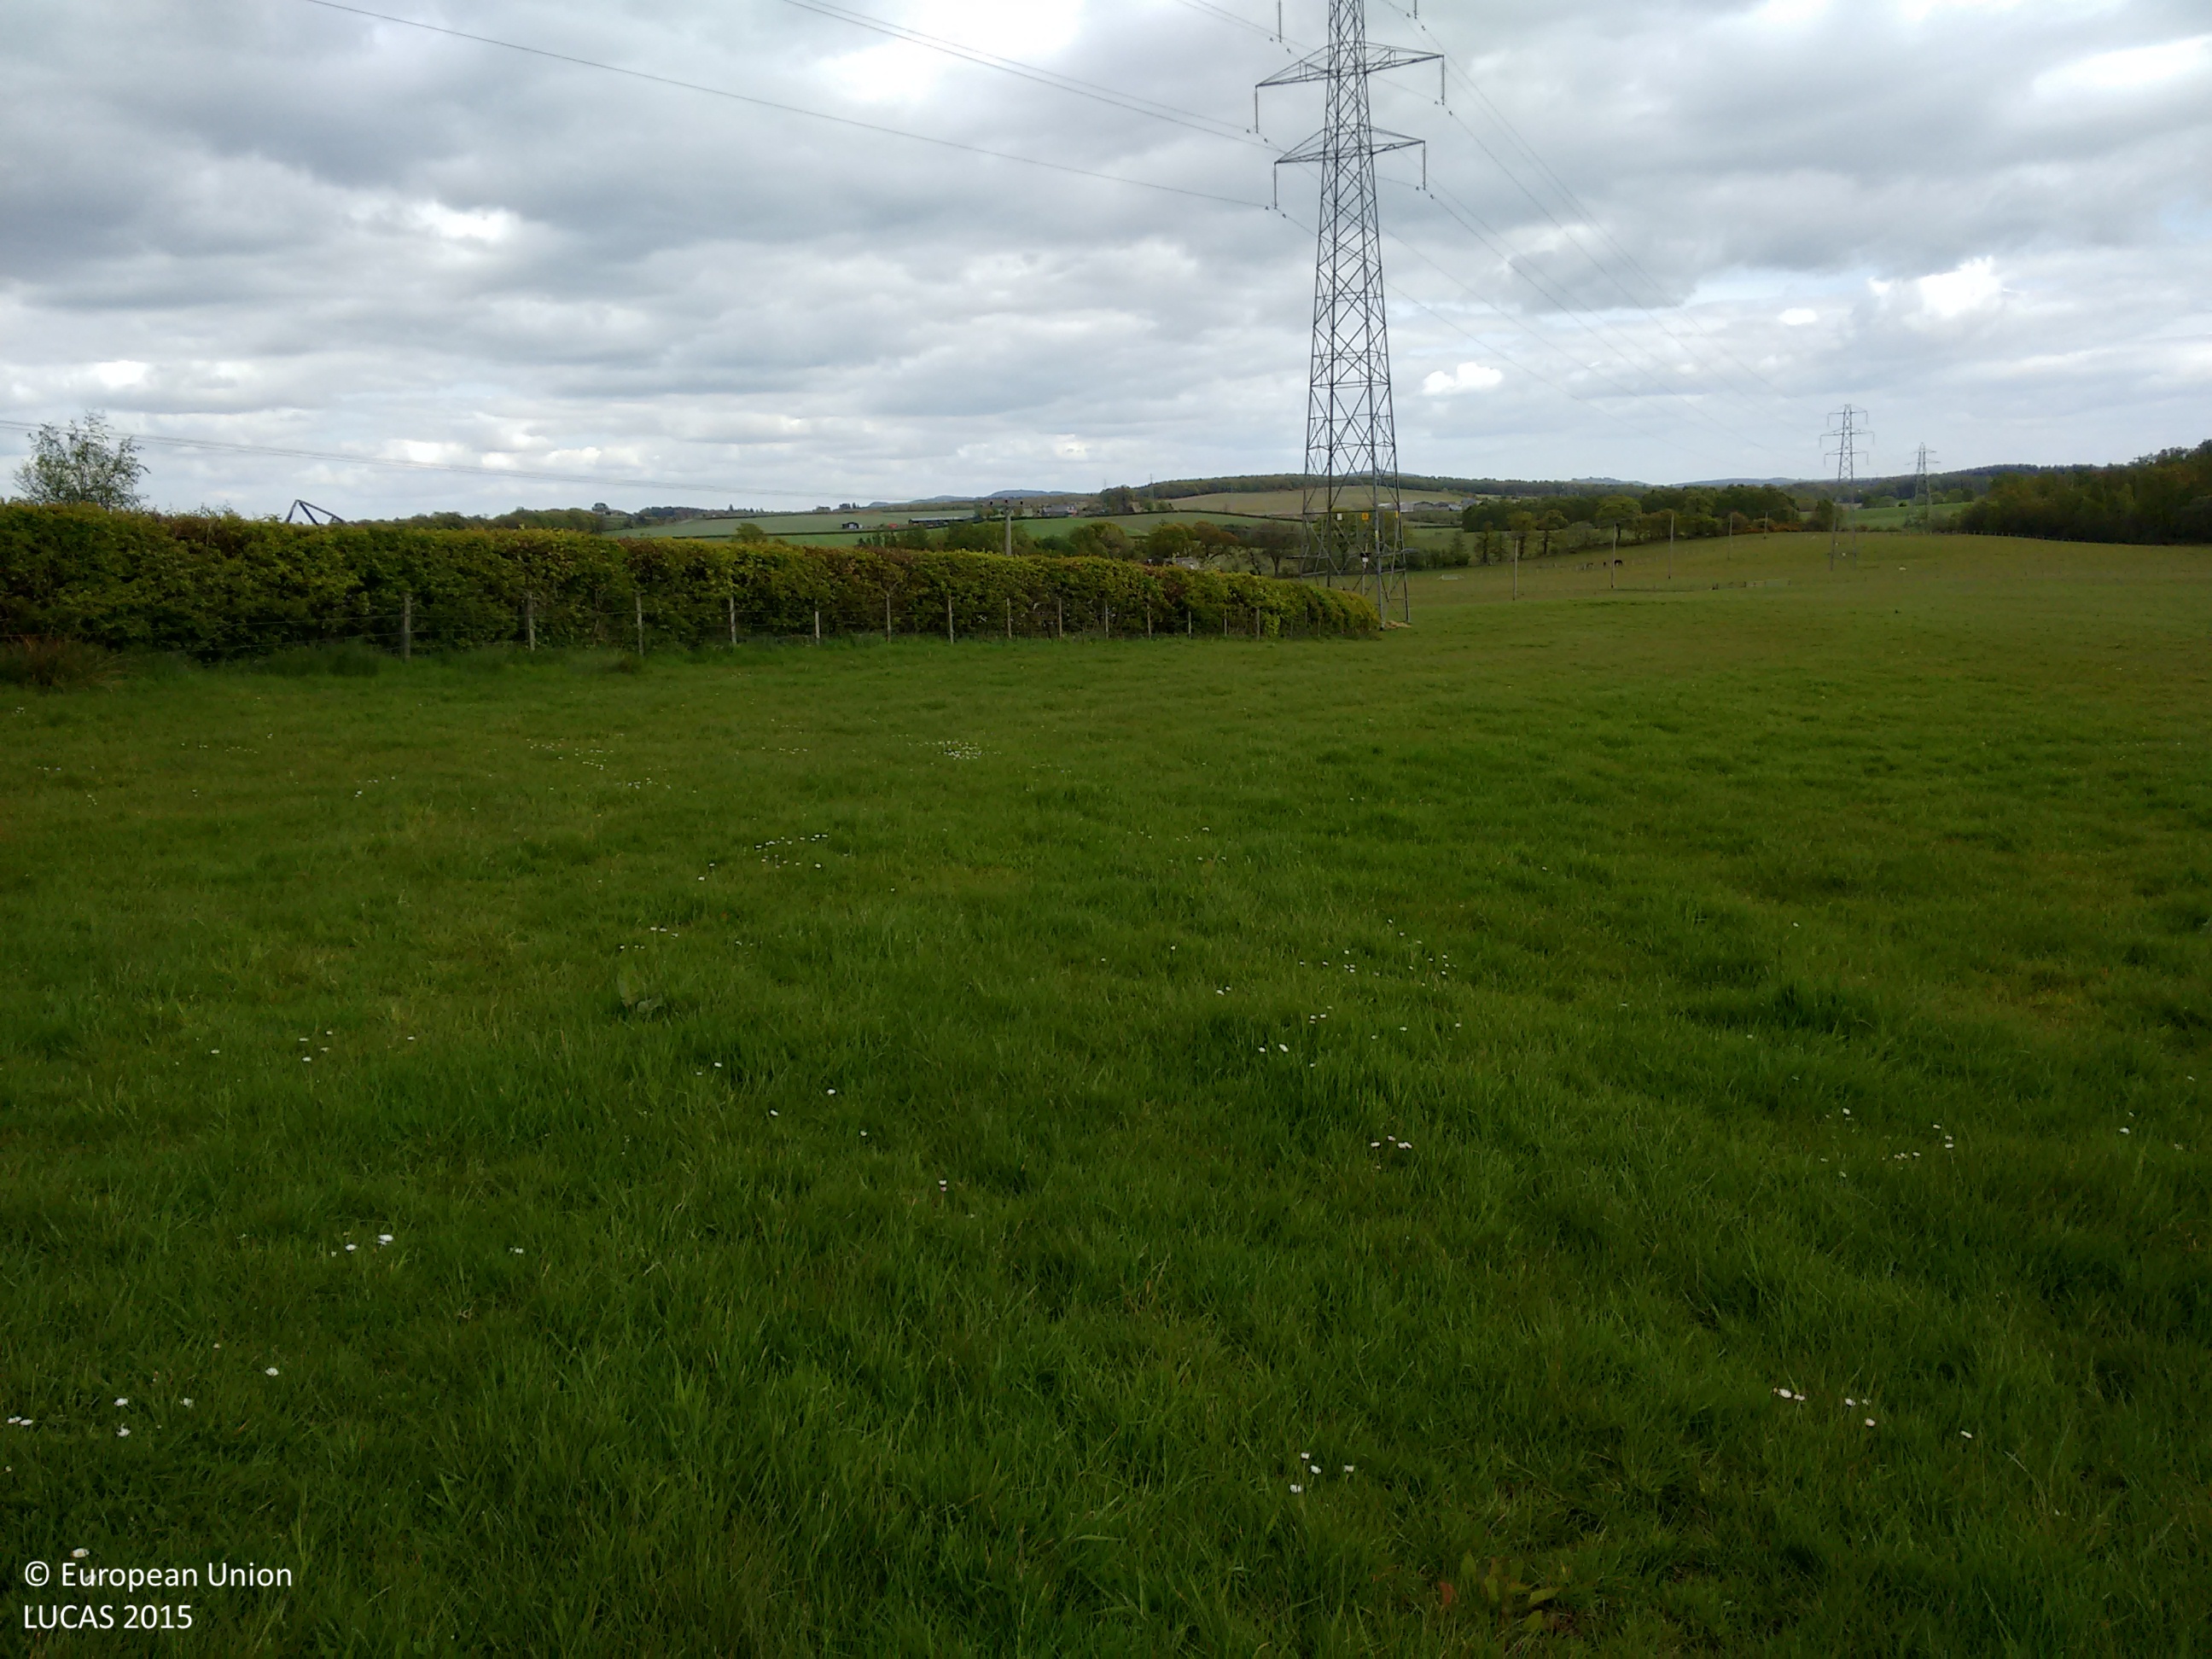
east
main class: Grassland
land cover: Grassland without tree/shrub cover
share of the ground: > 75 %
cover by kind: herbaceous plants 100 %
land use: Agriculture (excluding fallow land and kitchen gardens)
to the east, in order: Grassland without tree/shrub cover; Electric lines; Grassland without tree/shrub cover; Electric lines; Grassland without tree/shrub cover; Fences; Grassland without tree/shrub cover
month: May
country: GB
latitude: 56.1377
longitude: -3.7436
